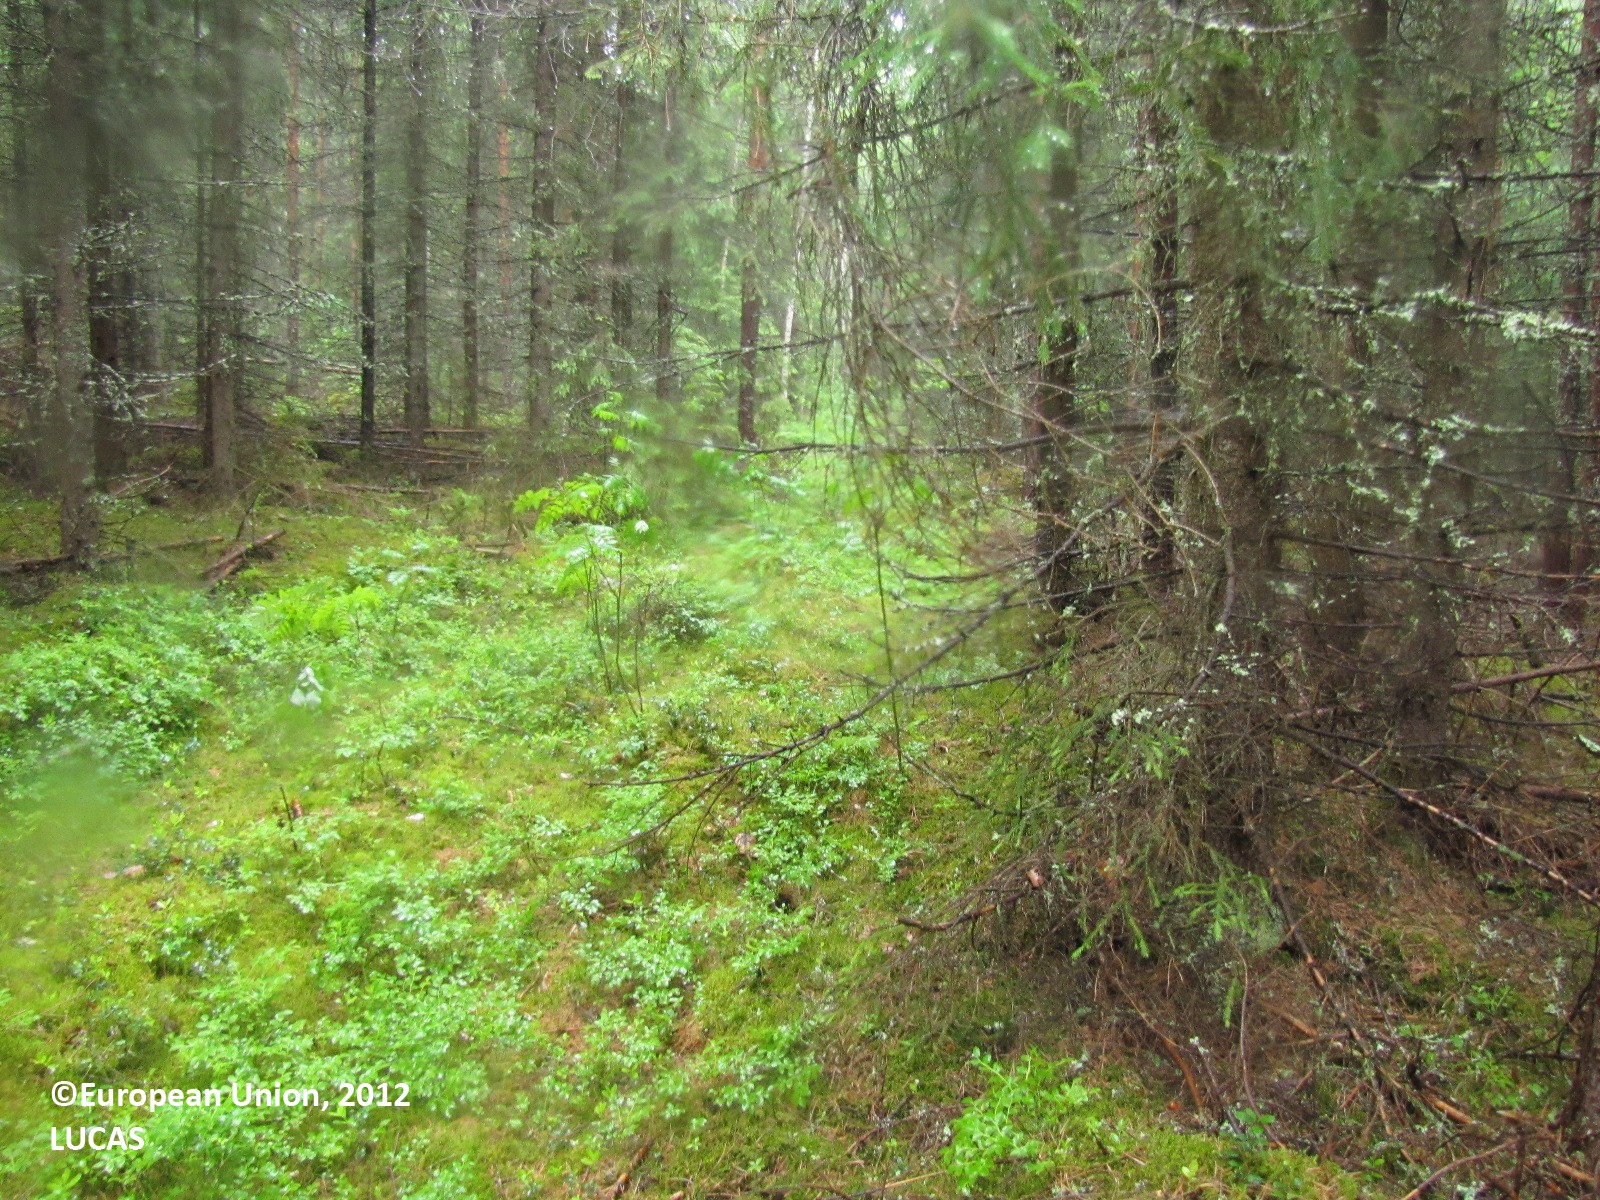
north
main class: Woodland
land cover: Spruce dominated coniferous woodland
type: boreal forest
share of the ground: > 75 %
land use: Forestry
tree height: > 5 m
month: June
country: FI
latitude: 61.6478
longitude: 24.4999
